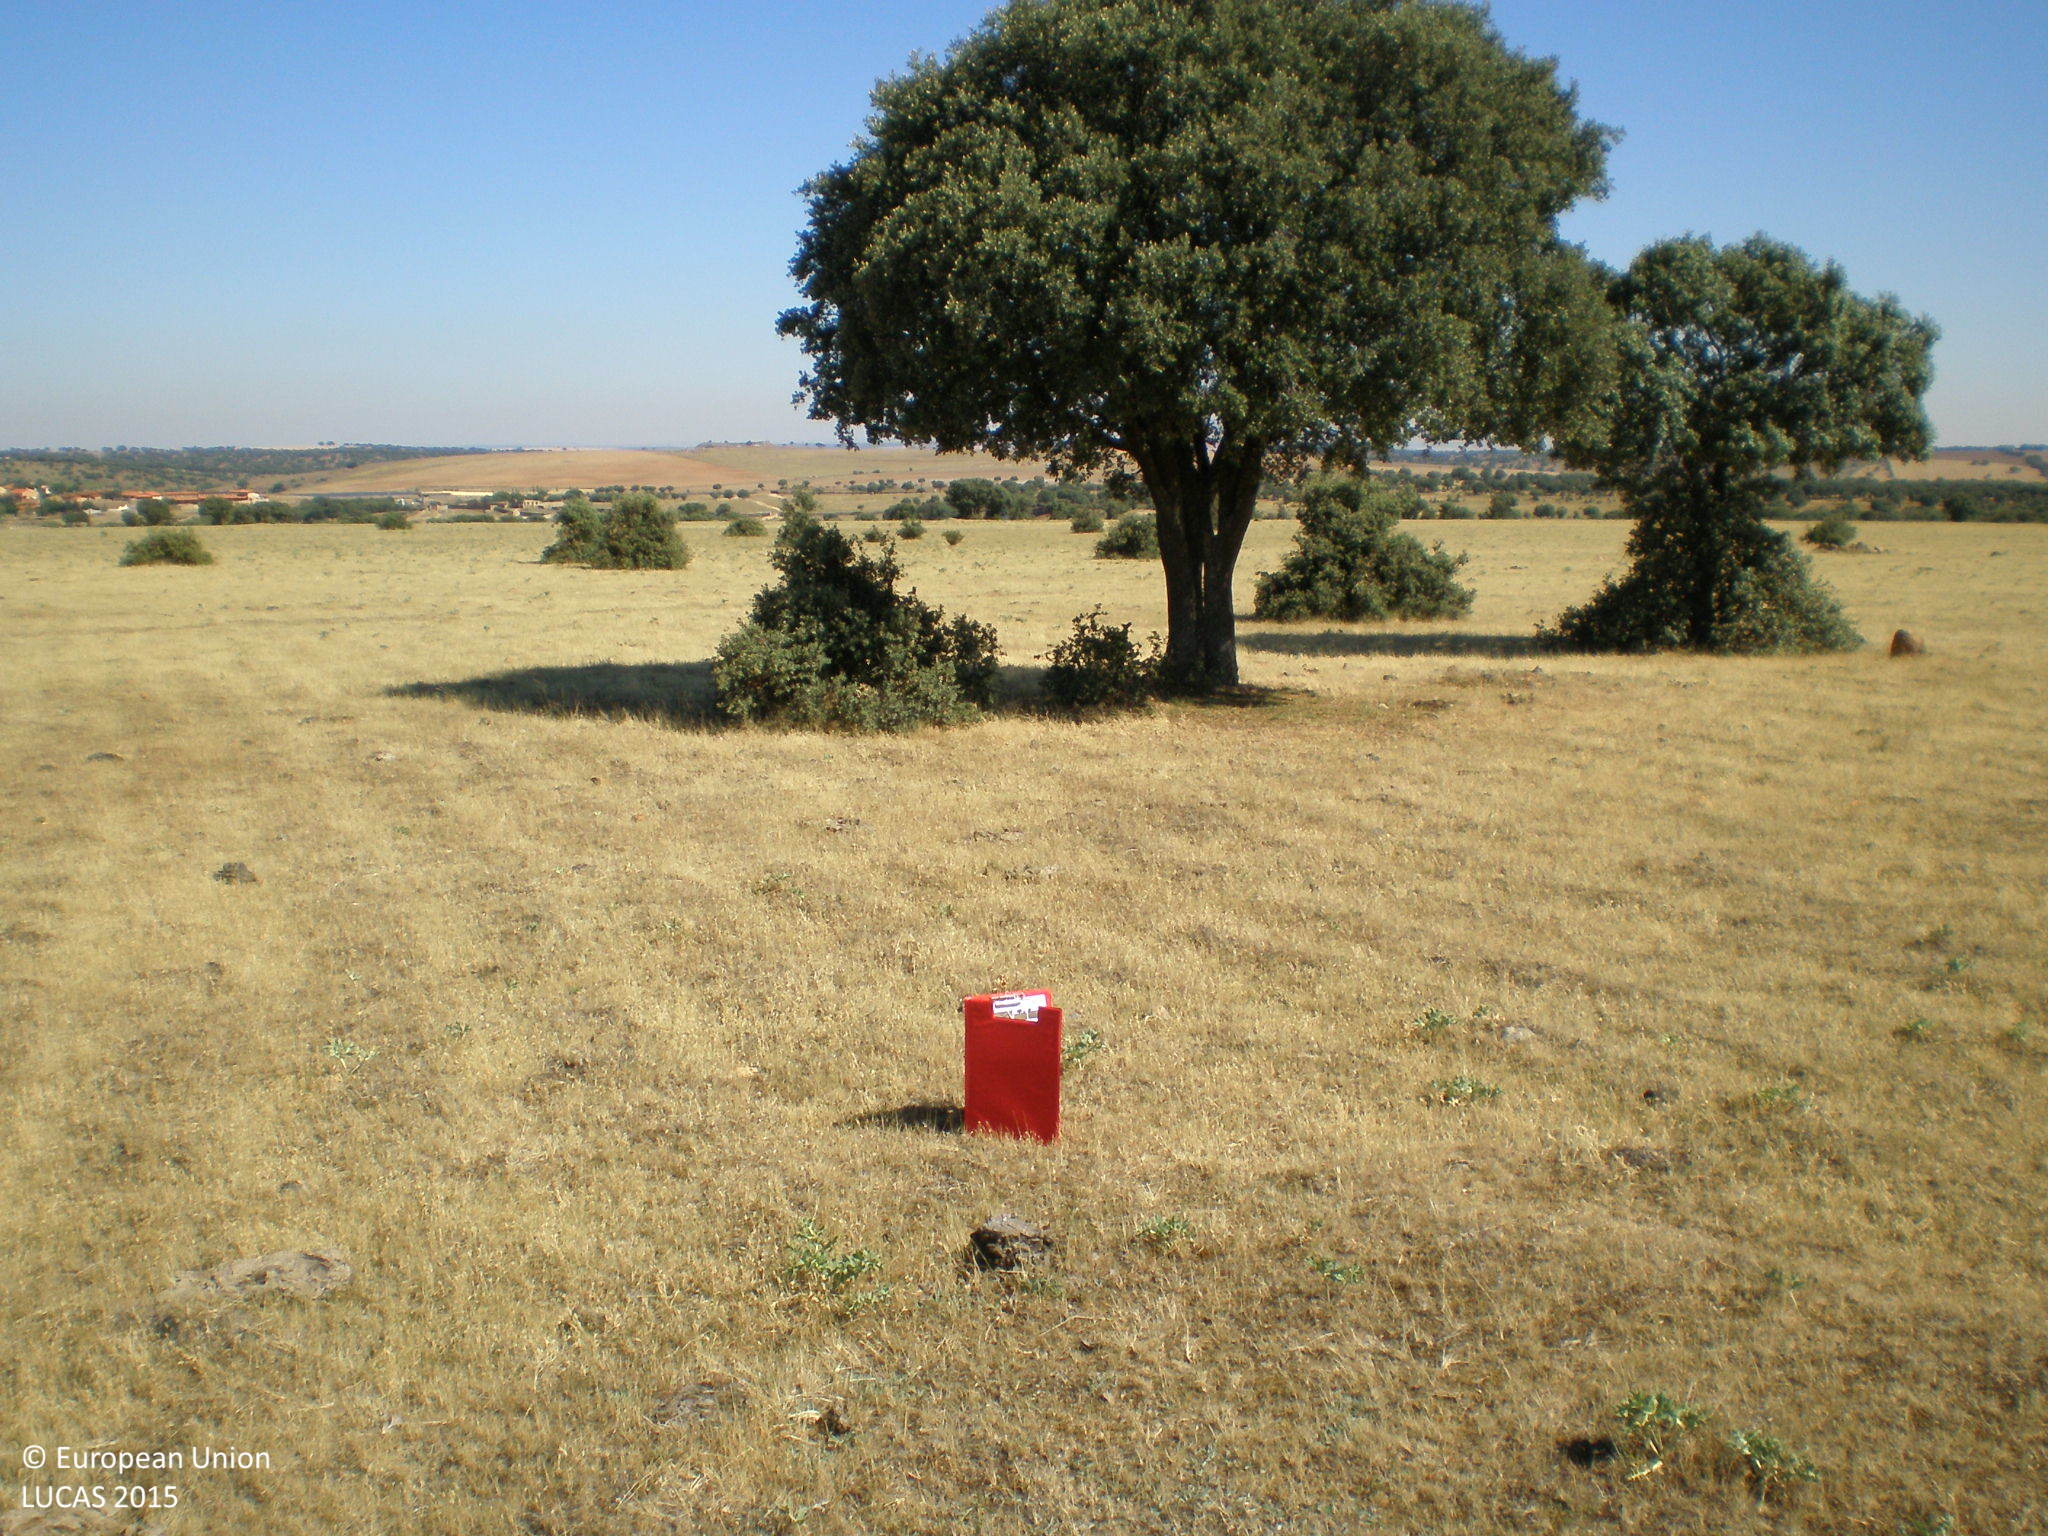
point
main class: Grassland
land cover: Grassland with sparse tree/shrub cover
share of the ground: > 75 %
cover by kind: herbaceous plants 95 %, broadleaved forest trees 5 %
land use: Agriculture (excluding fallow land and kitchen gardens)
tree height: < 5 m
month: June
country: ES
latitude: 40.7986
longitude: -5.6850
